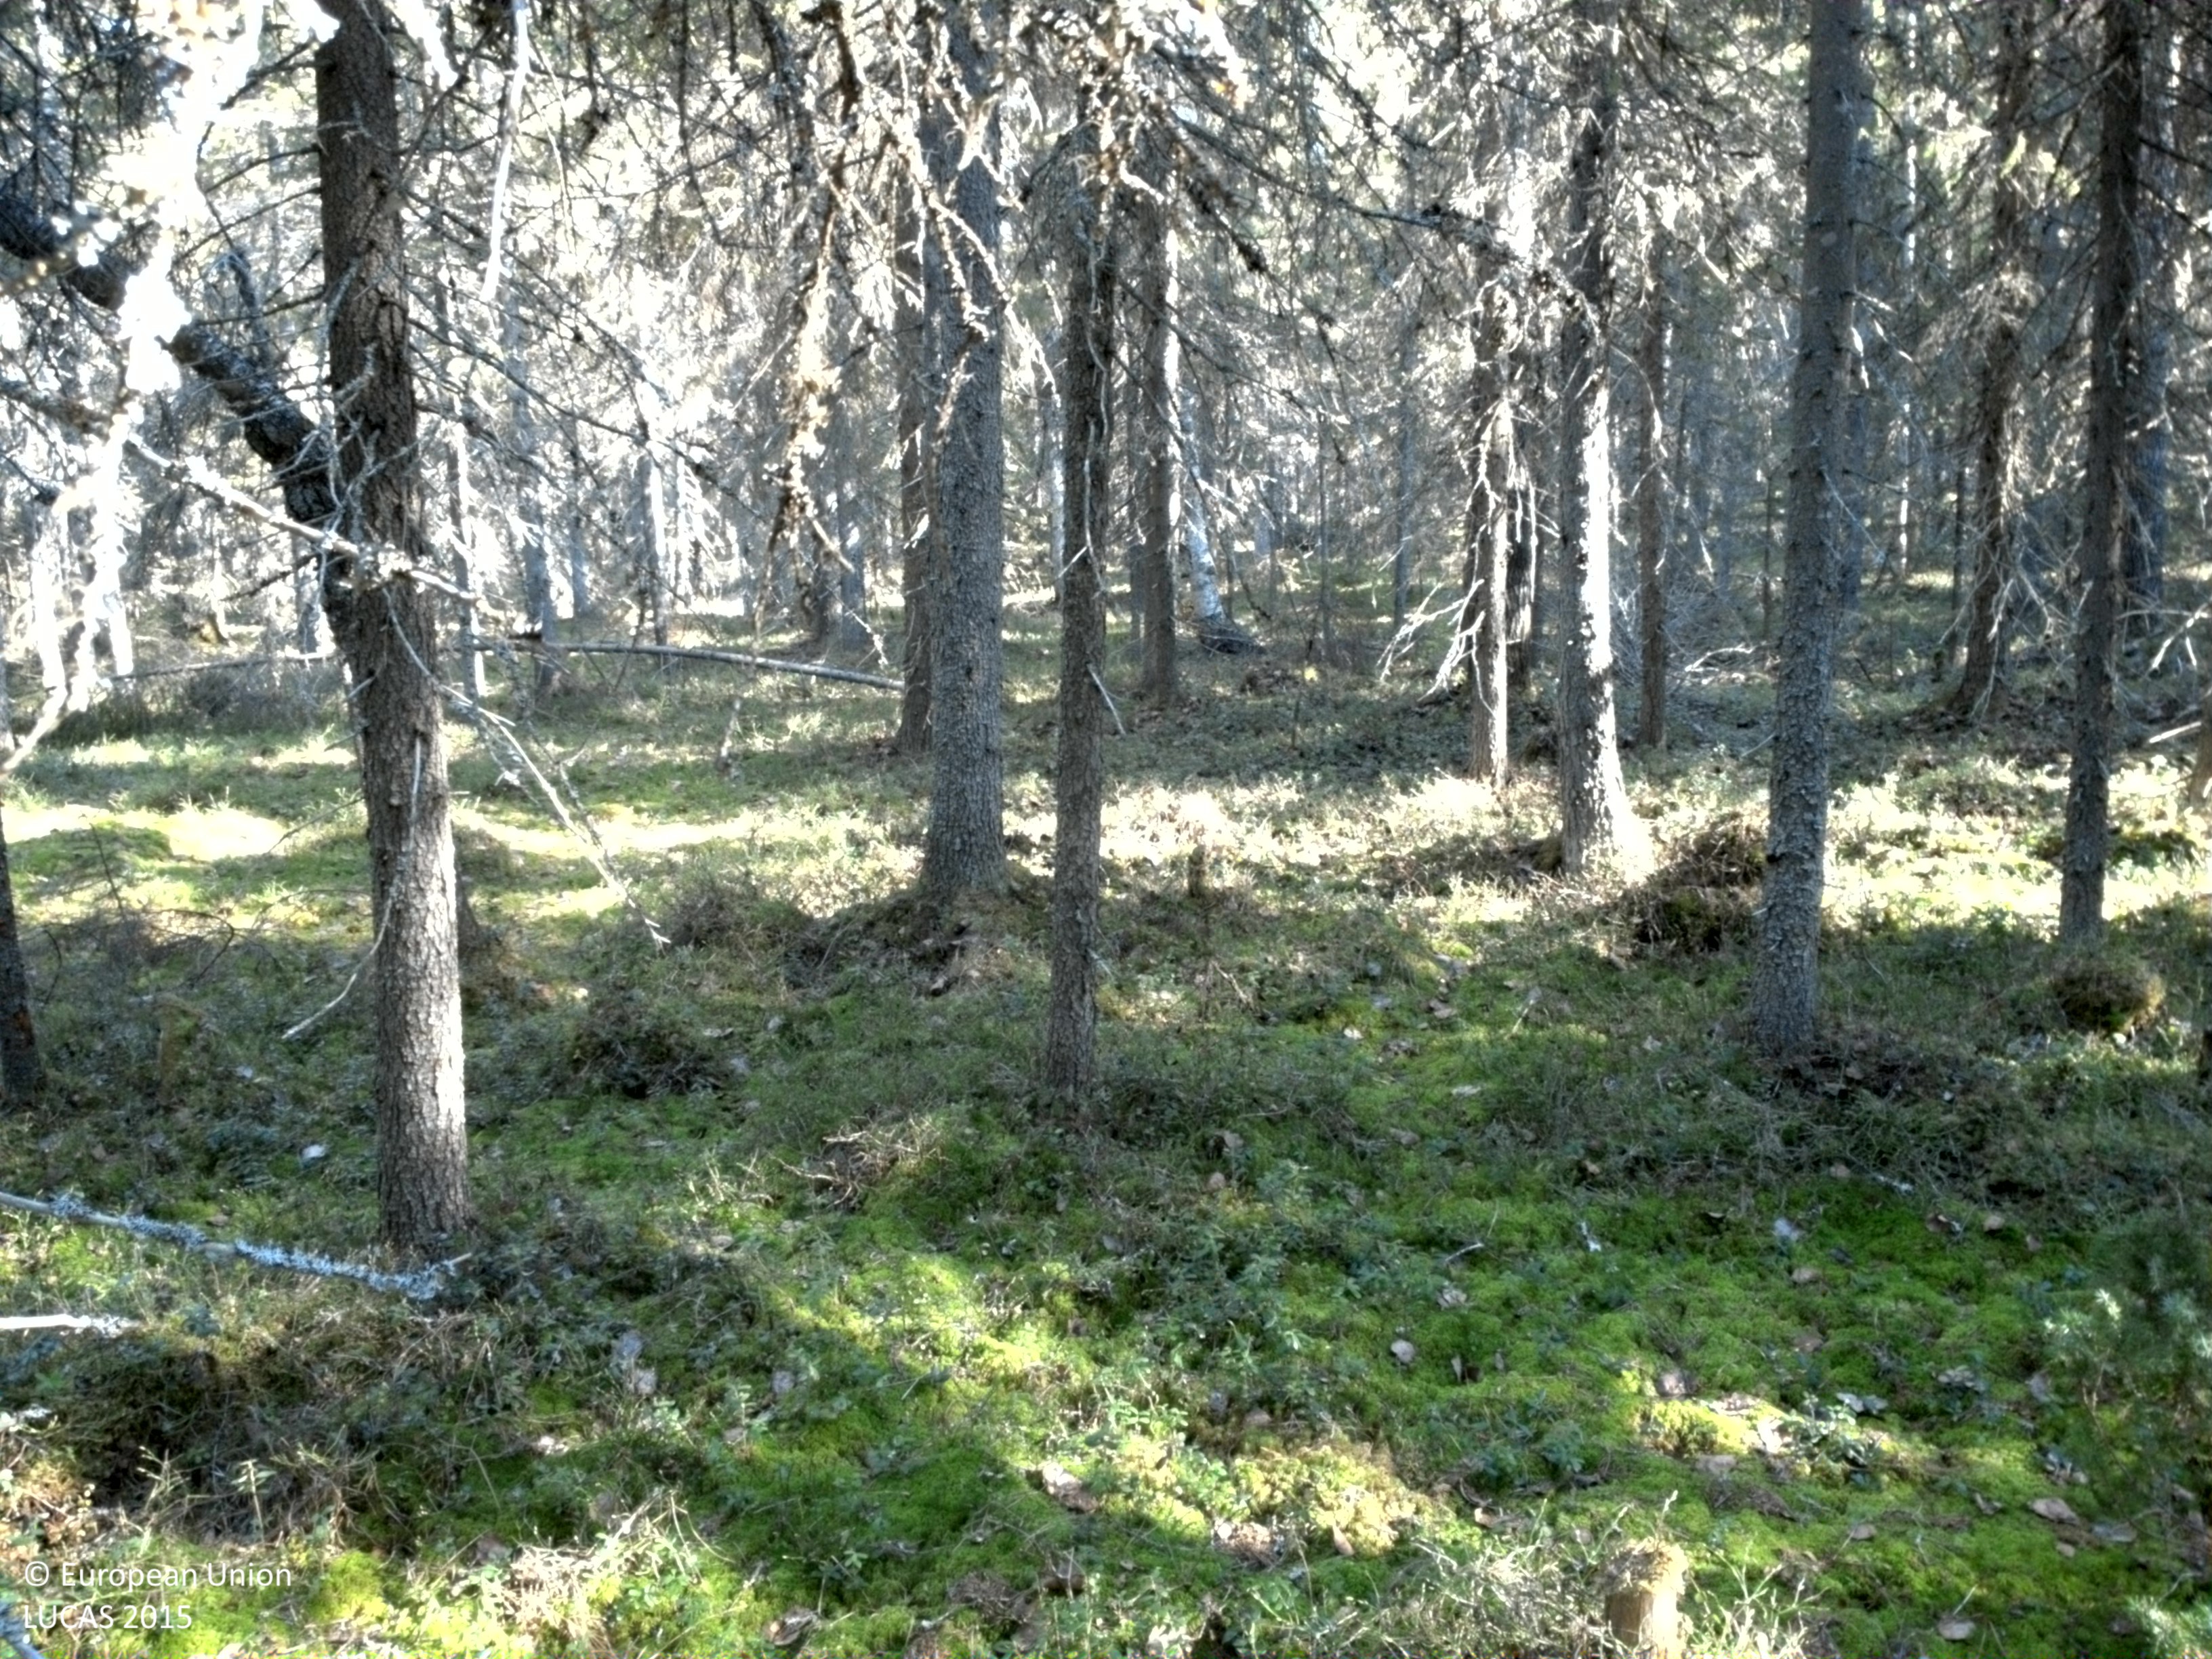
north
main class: Woodland
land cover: Spruce dominated coniferous woodland
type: boreal forest
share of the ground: > 75 %
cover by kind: coniferous forest trees 75 %, lichens and mosses 15 %, shrubs 10 %
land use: Forestry
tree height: > 5 m
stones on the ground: < 10 %
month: May
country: SE
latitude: 65.8797
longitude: 23.2569
